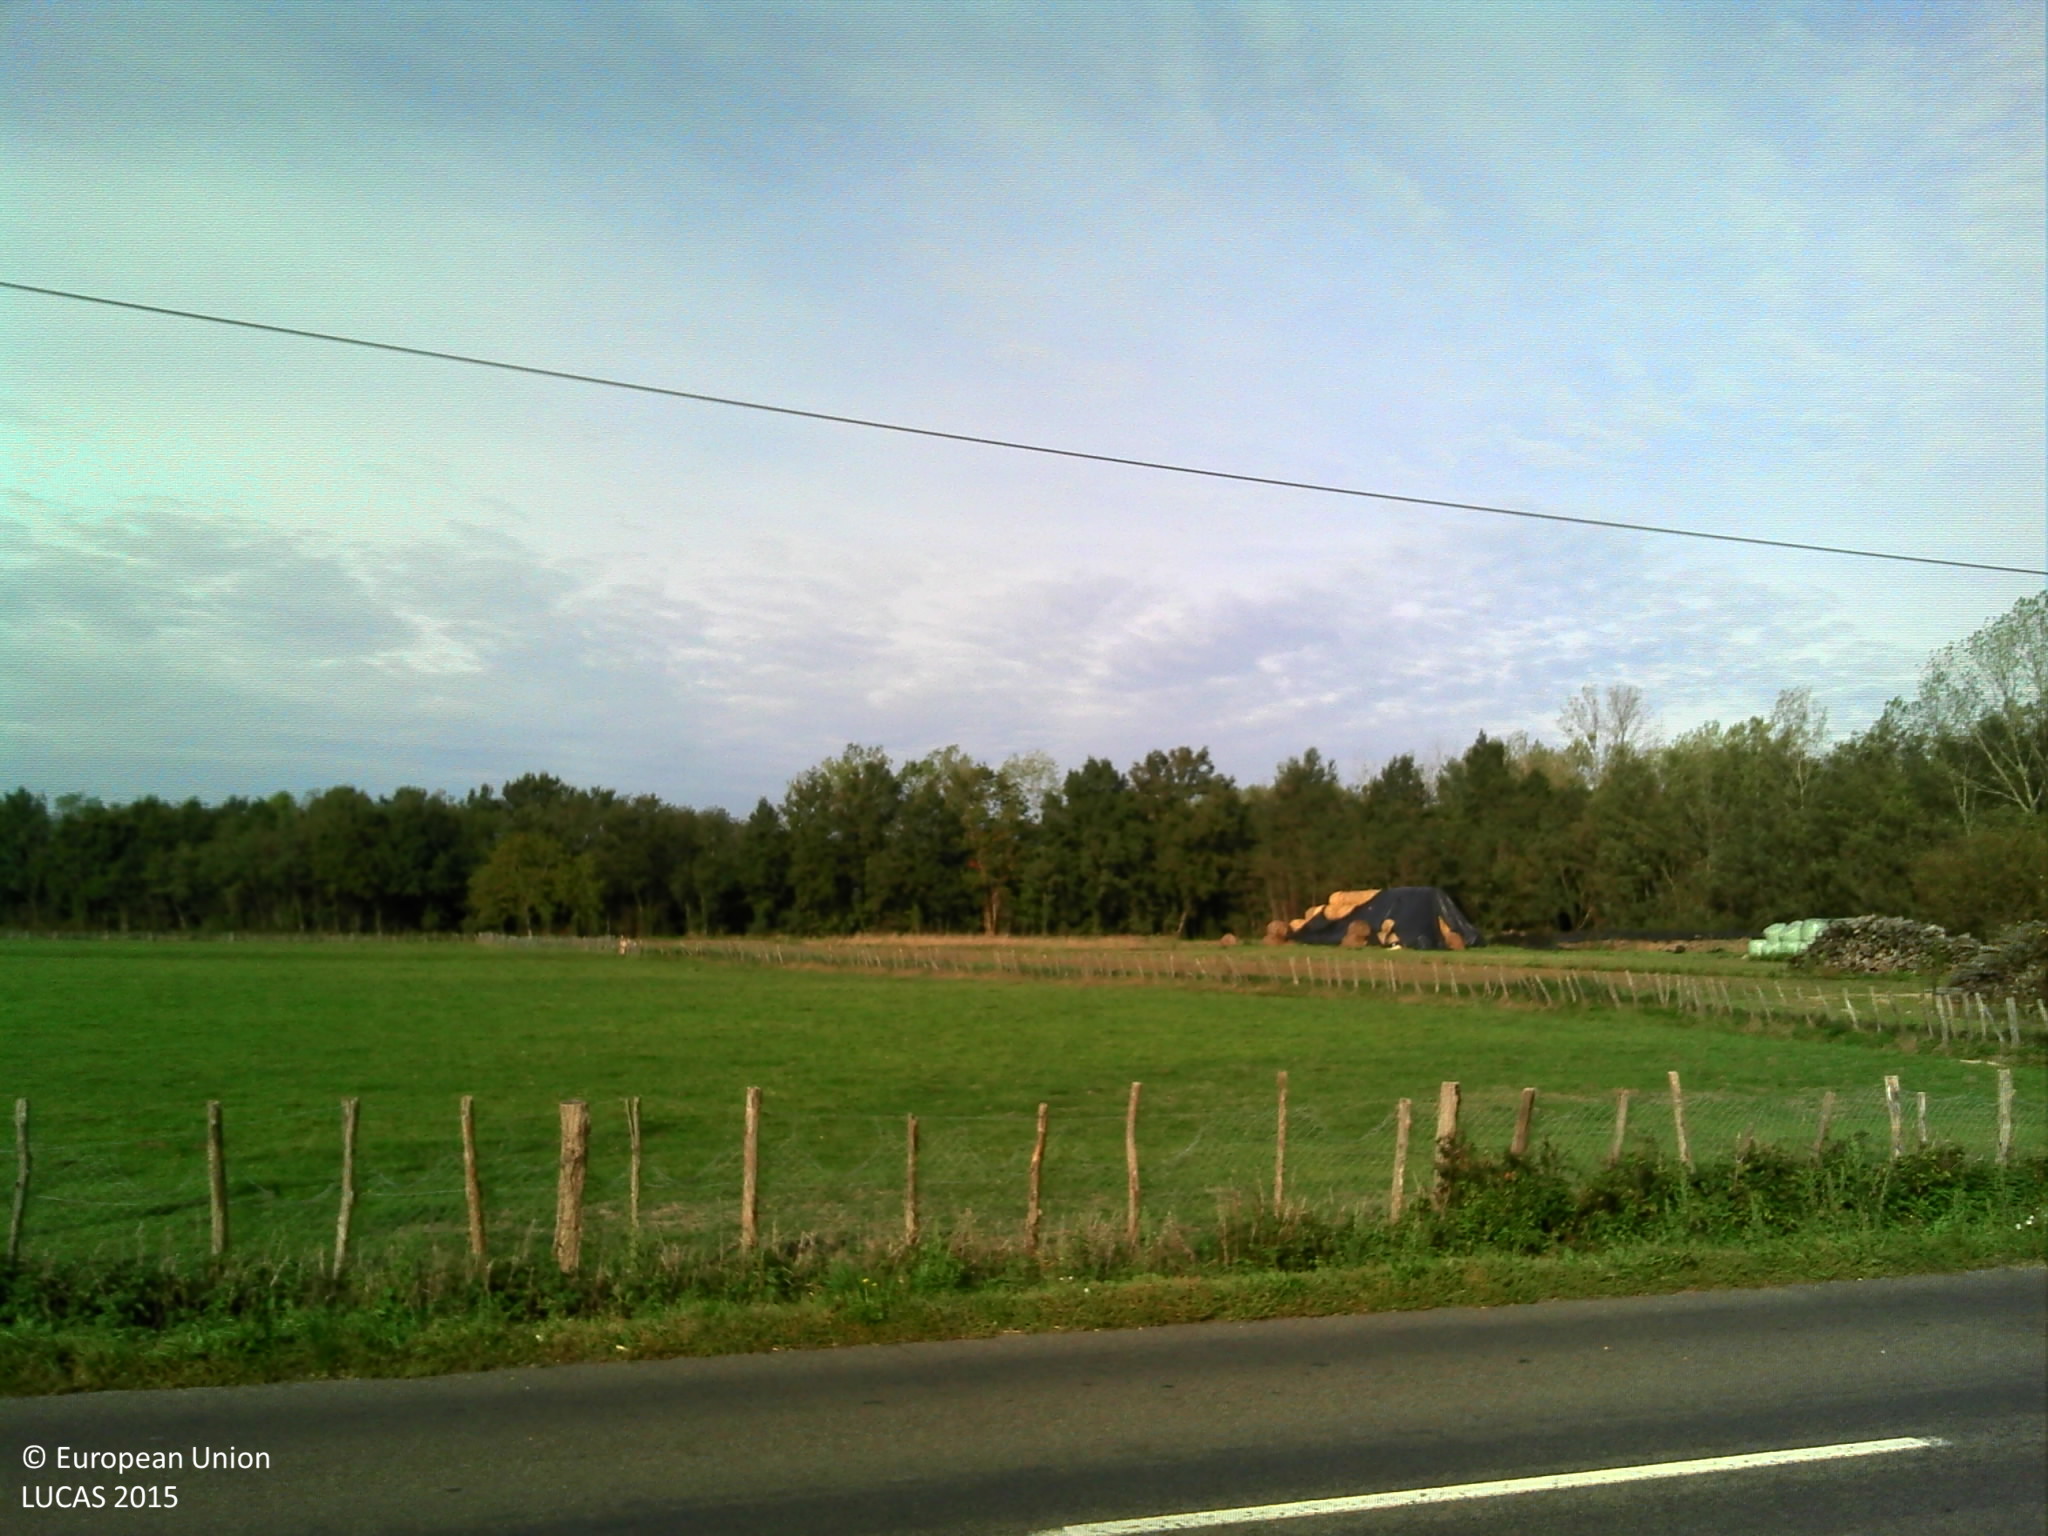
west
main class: Grassland
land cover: Grassland with sparse tree/shrub cover
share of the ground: > 75 %
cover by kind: herbaceous plants 95 %, broadleaved forest trees 5 %
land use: Residential
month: December
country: FR
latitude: 46.4120
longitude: 4.9416
